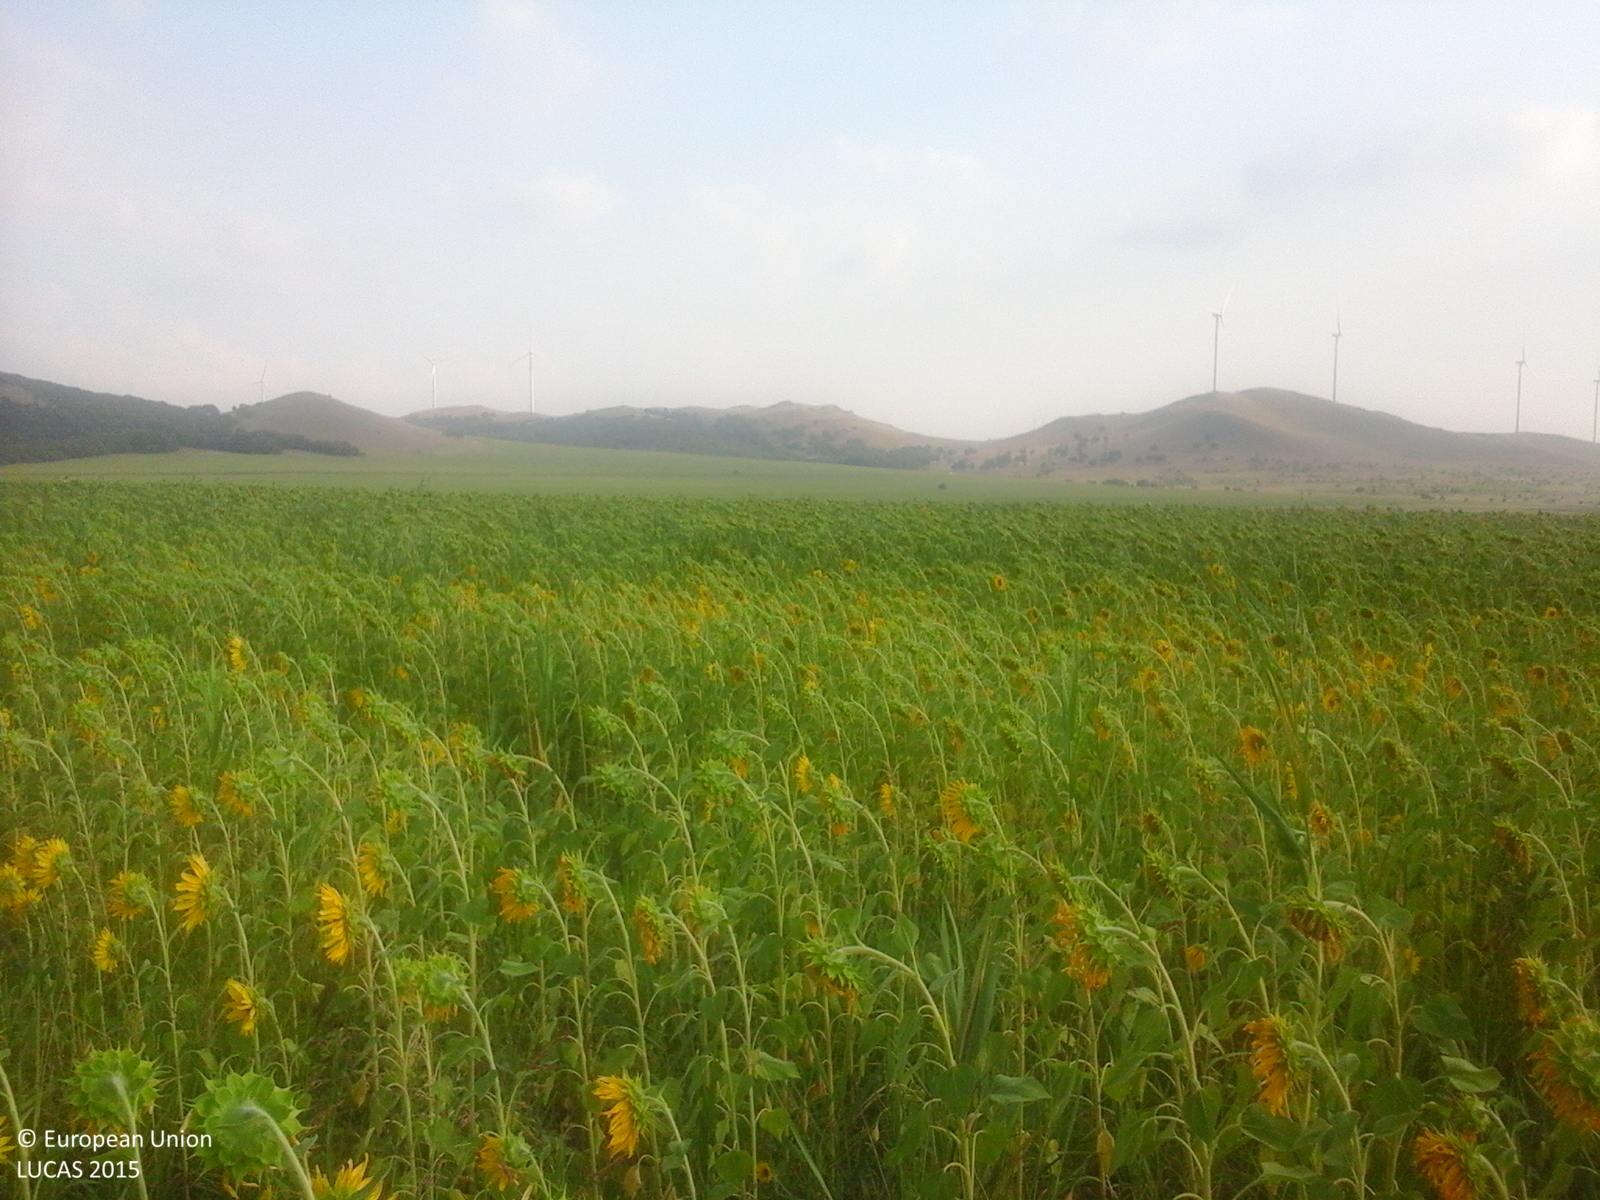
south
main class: Cropland
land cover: Sunflower
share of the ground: > 75 %
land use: Agriculture (excluding fallow land and kitchen gardens)
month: July
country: RO
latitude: 45.0992
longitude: 28.3348
